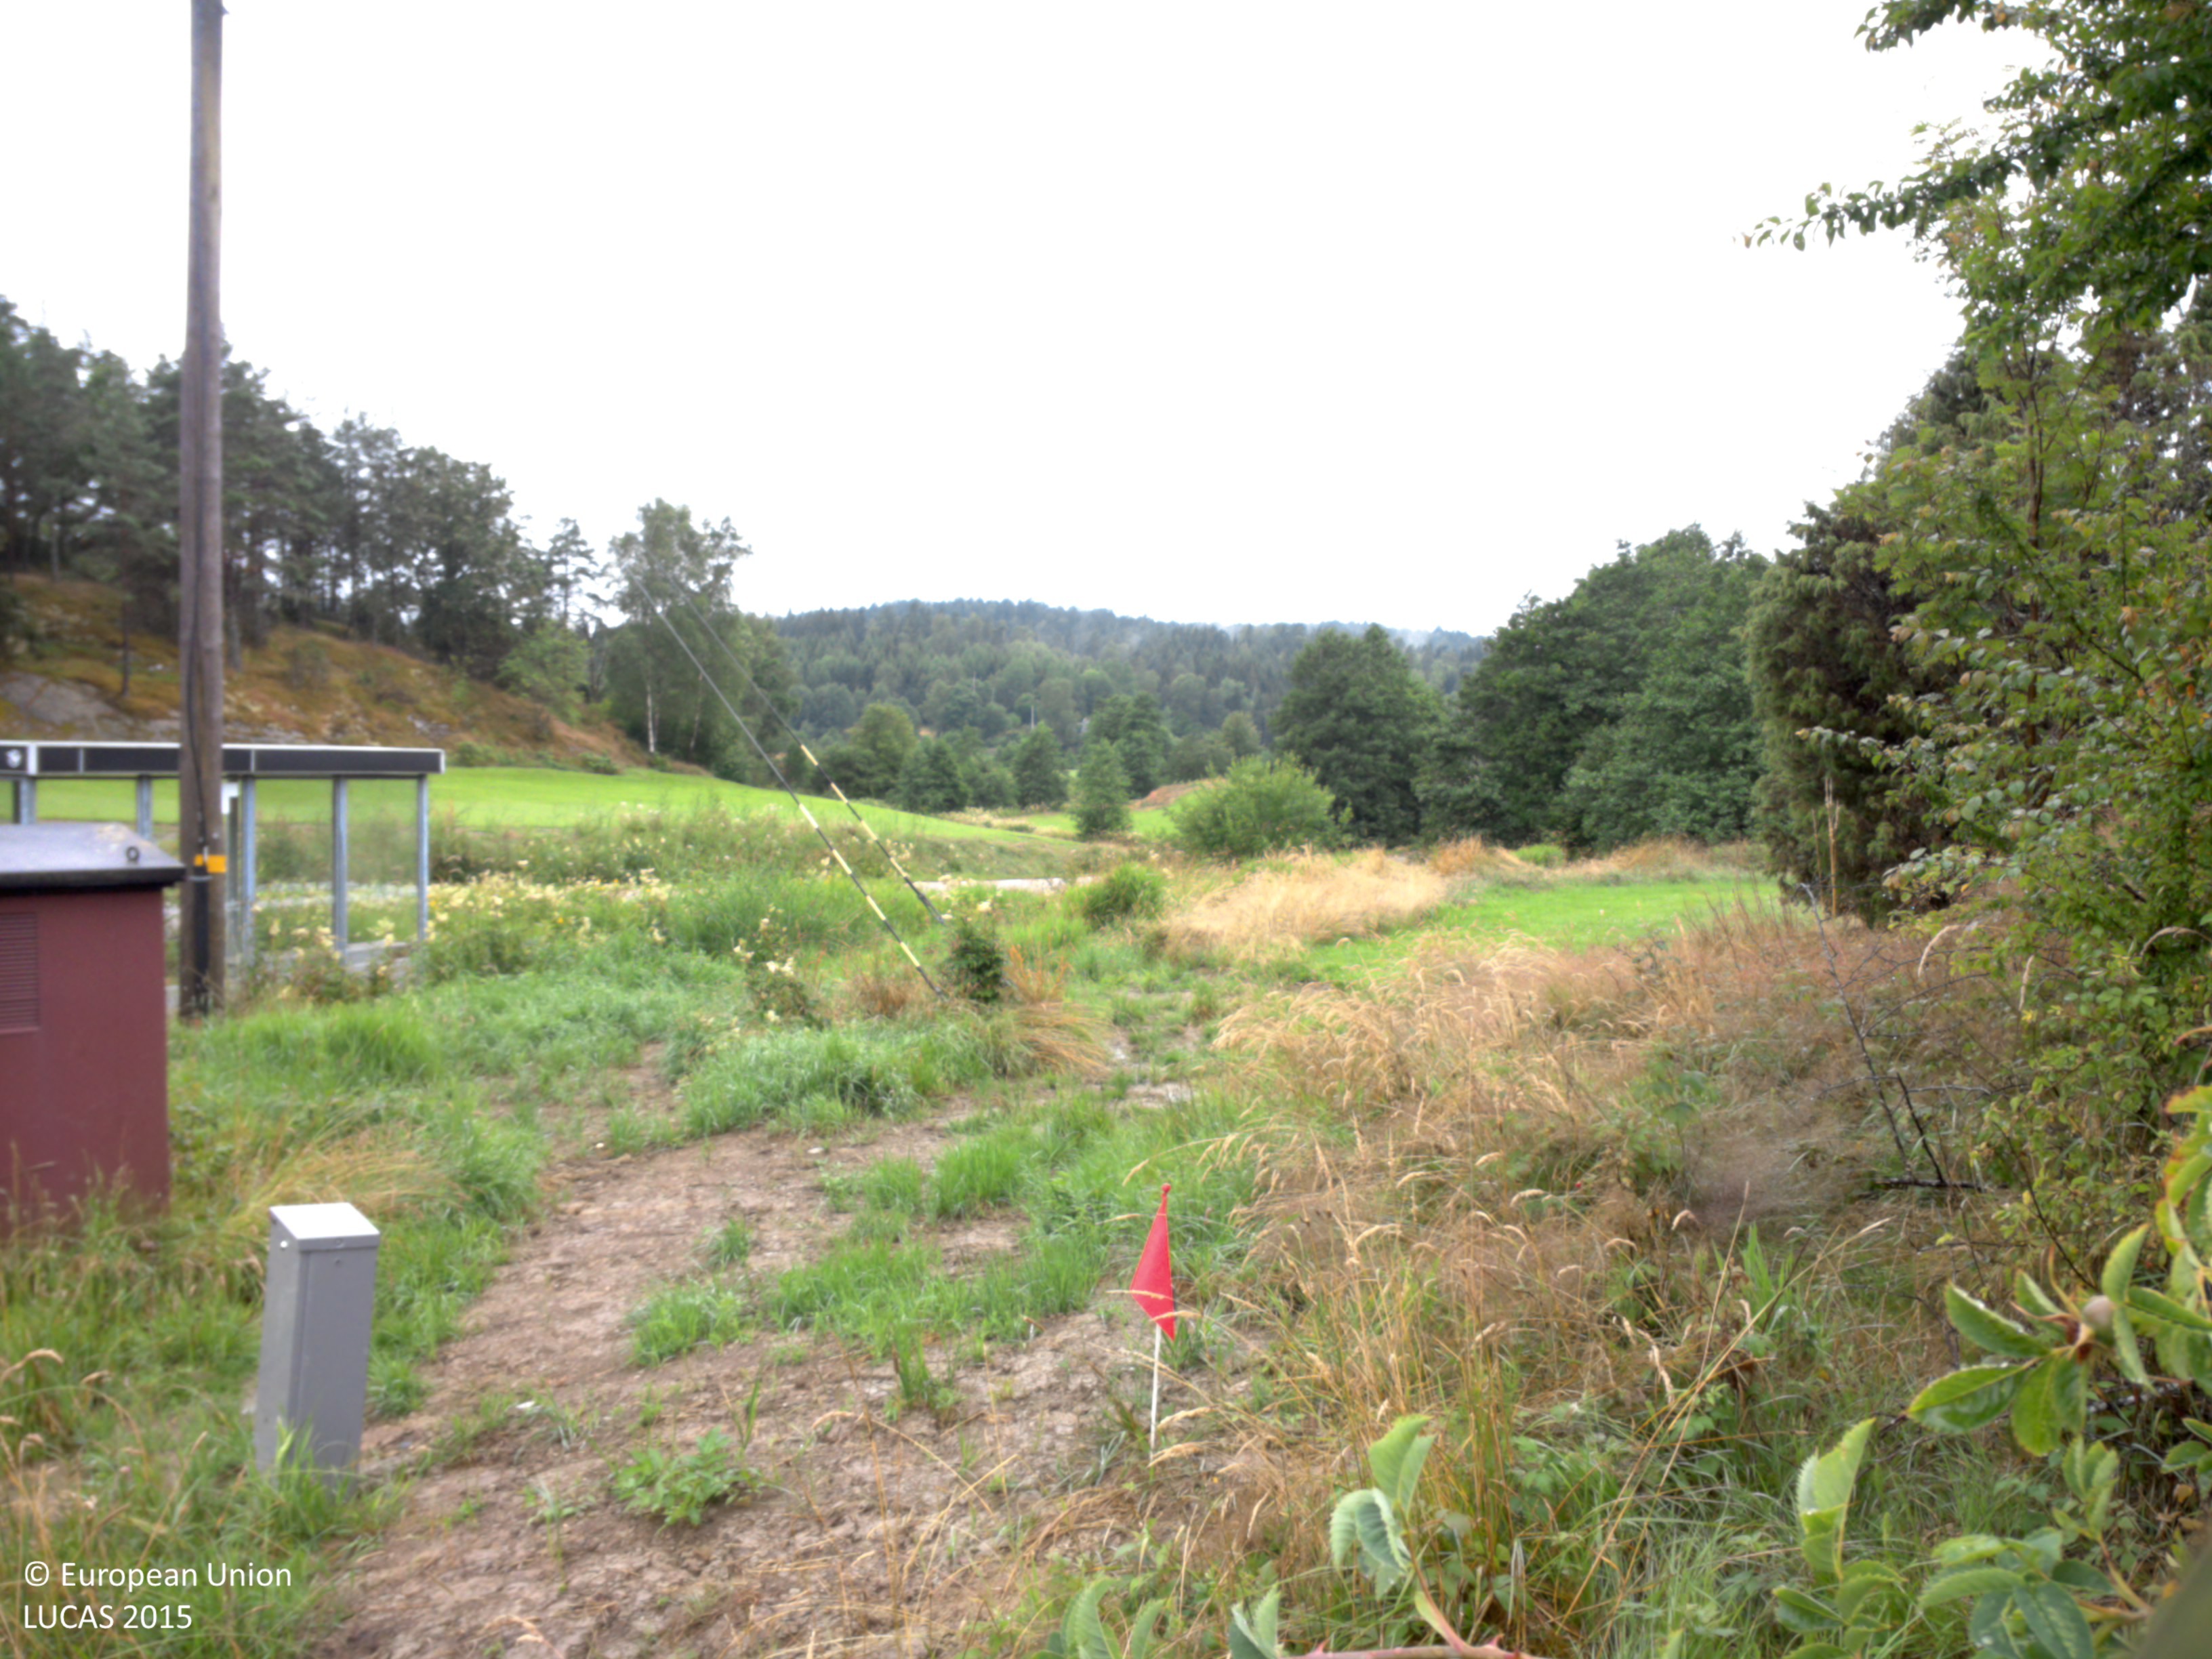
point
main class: Grassland
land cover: Grassland without tree/shrub cover
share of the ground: > 75 %
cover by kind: herbaceous plants 95 %, shrubs 5 %
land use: Abandoned areas
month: July
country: SE
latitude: 58.2947
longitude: 11.9921
